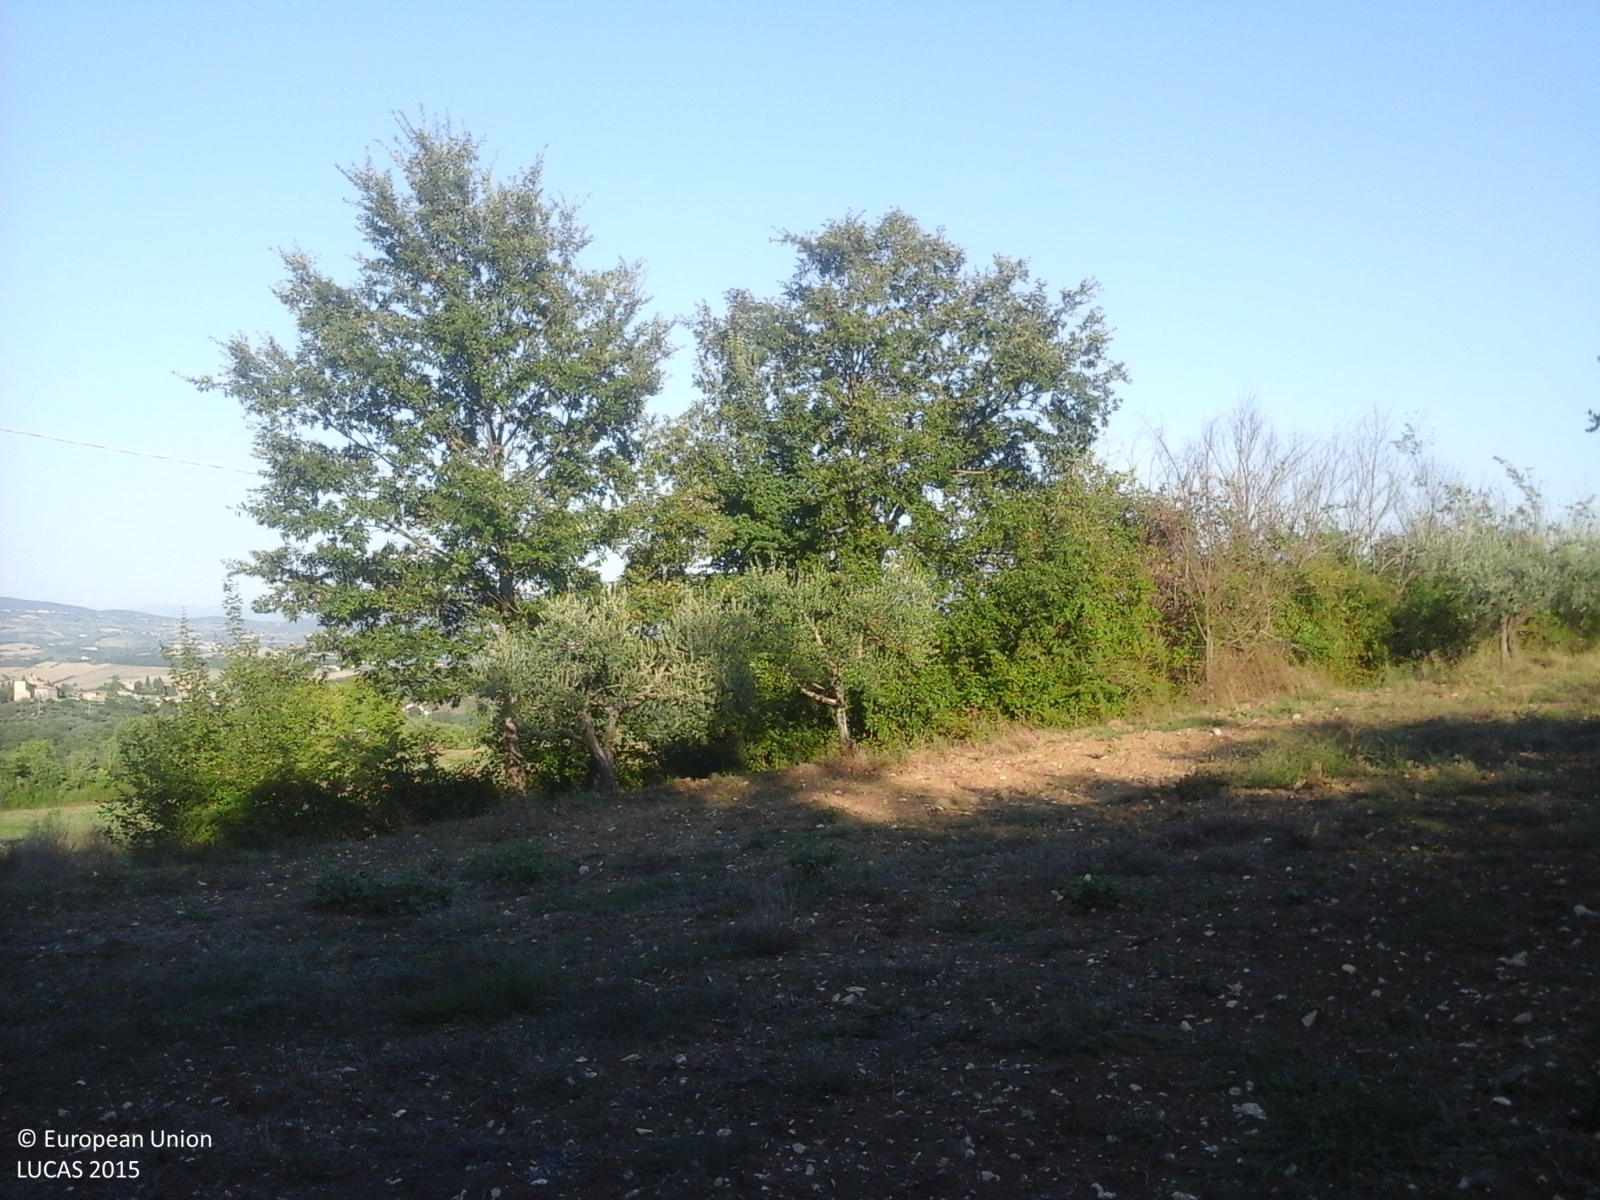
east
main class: Woodland
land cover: Broadleaved woodland
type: thermophilous deciduous forest
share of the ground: > 75 %
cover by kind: broadleaved forest trees 70 %, shrubs 20 %, herbaceous plants 10 %
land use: Forestry
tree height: > 5 m
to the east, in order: Broadleaved woodland; Spontaneously vegetated surfaces; Electric lines; Lucerne; Single bushes/trees; Dry pulses; Artificial constructions in urban areas; Broadleaved woodland; Tracks; Ditches and canals; Dry pulses; Abandoned hedges; Electric lines; Lucerne
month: August
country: IT
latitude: 42.8254
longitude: 12.3535
